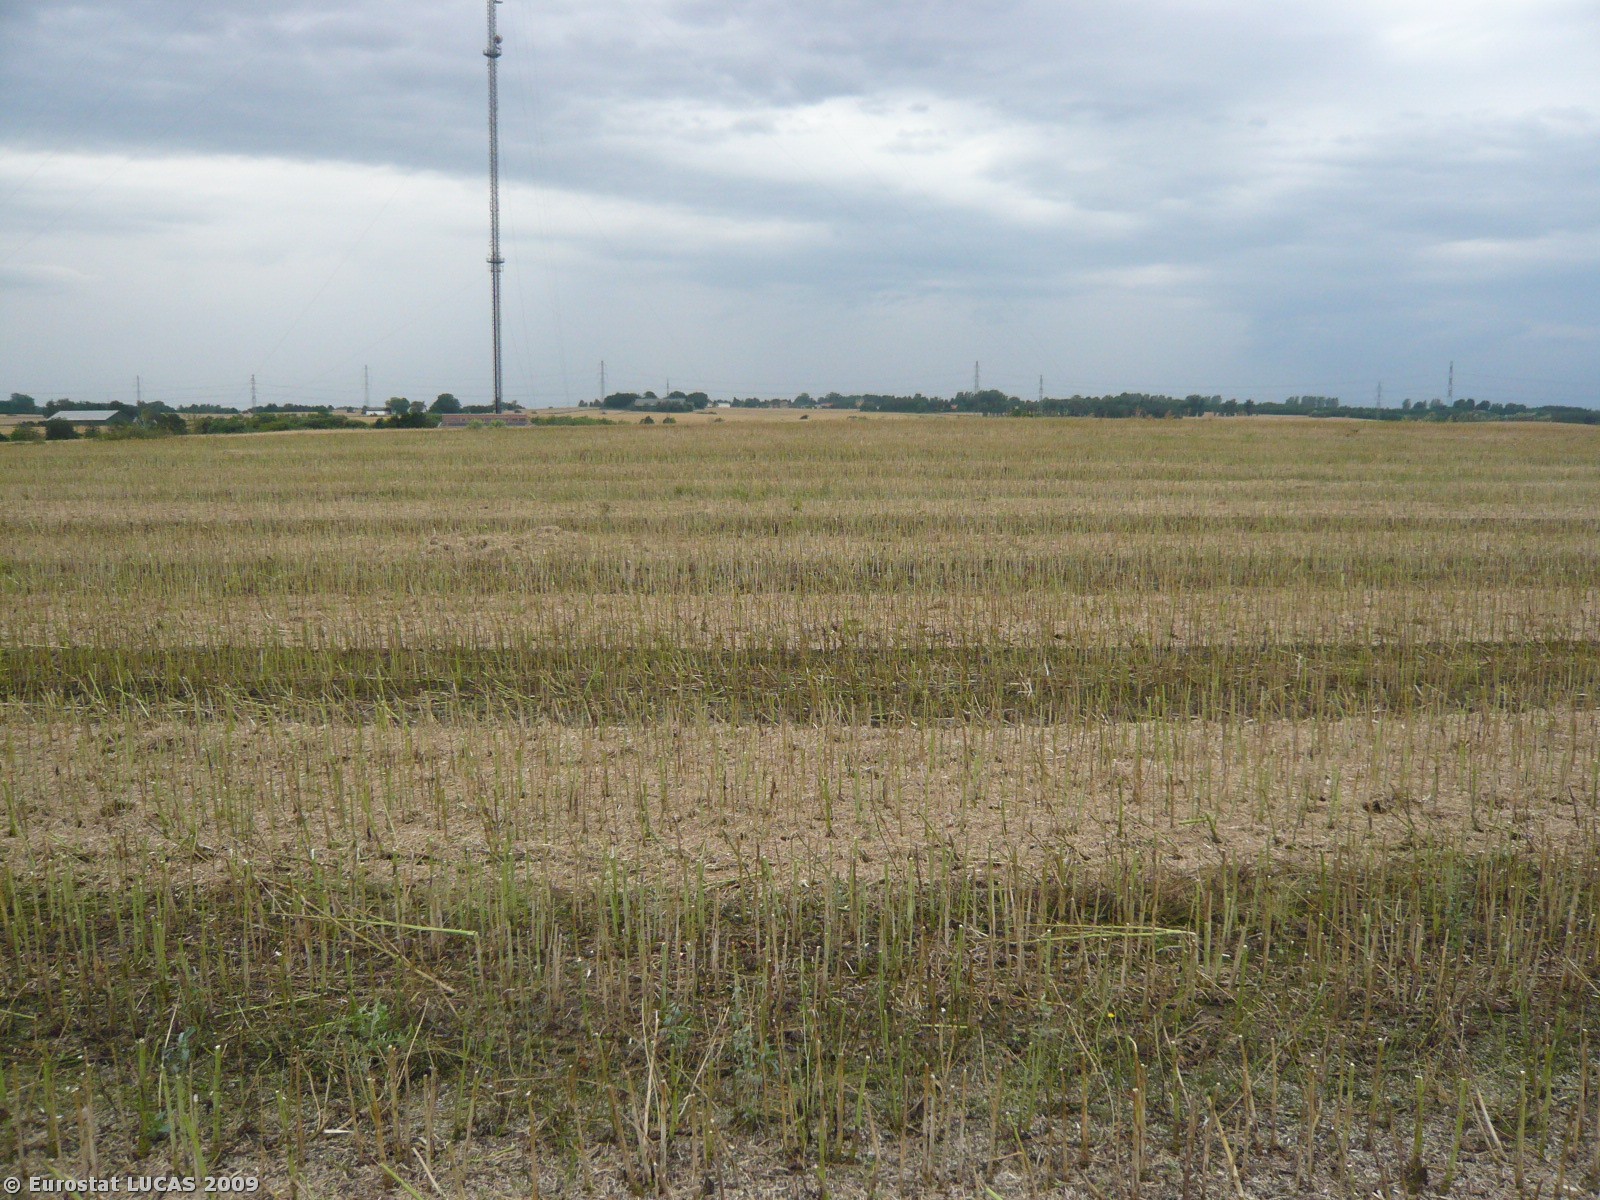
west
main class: Cropland
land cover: Rape and turnip rape
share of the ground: < 10 %
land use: Agriculture (excluding fallow land and kitchen gardens)
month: July
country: DK
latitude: 55.7186
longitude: 12.2427
